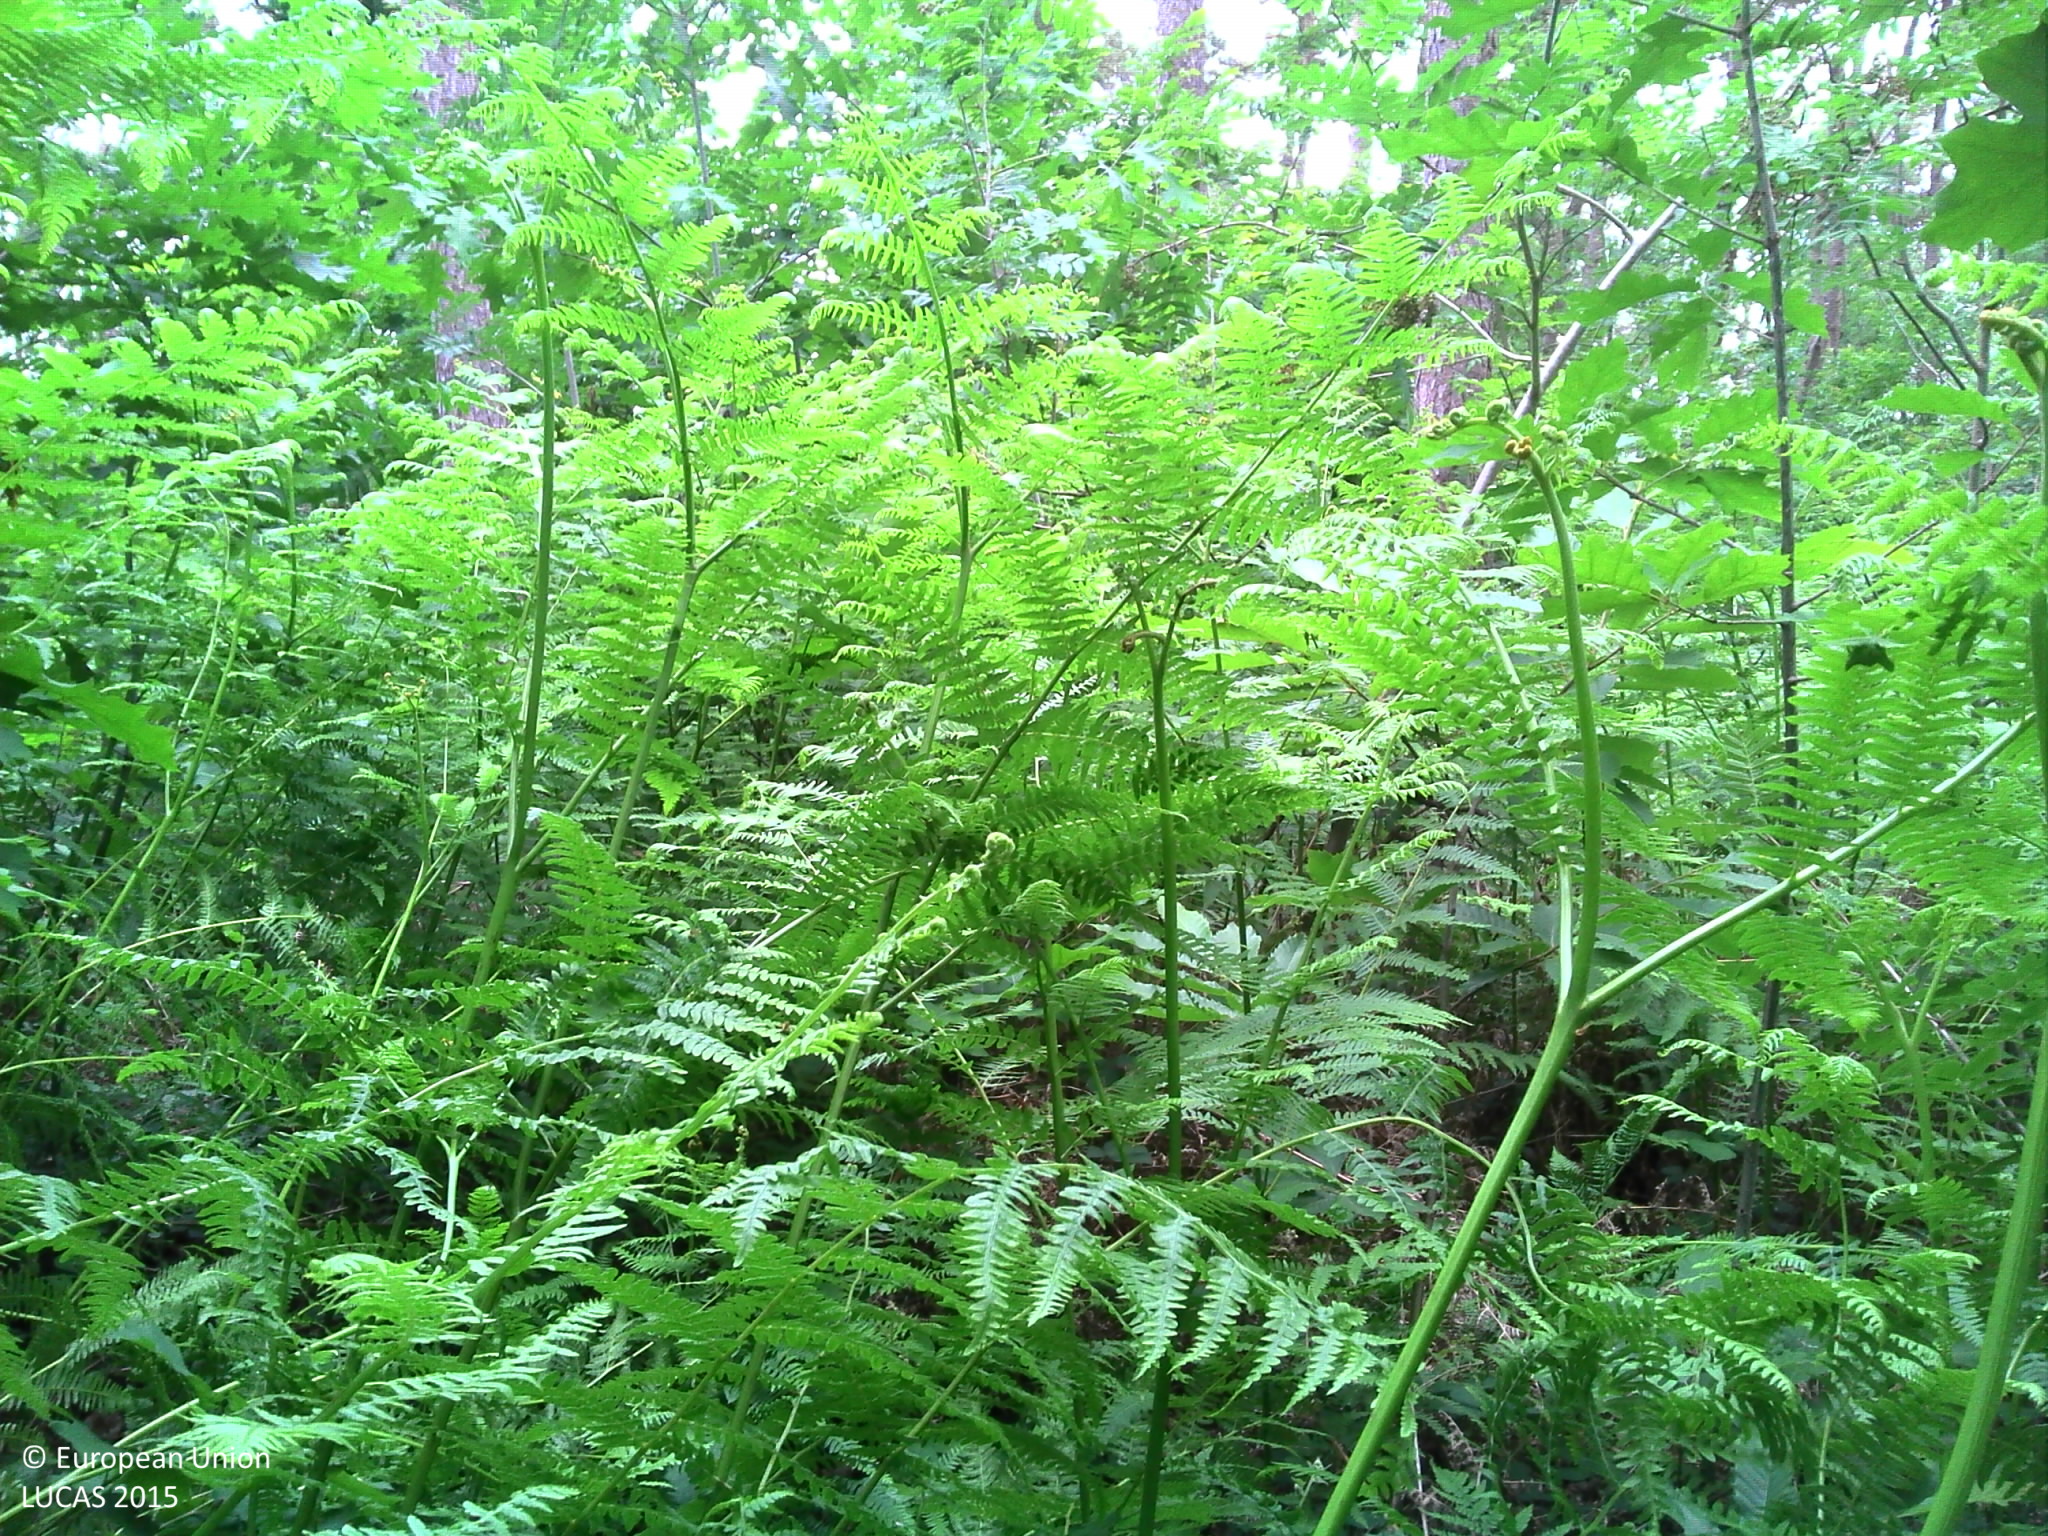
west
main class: Woodland
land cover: Pine dominated mixed woodland
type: acidophilous oak and oak-birch forest
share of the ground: > 75 %
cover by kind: broadleaved forest trees 40 %, shrubs 35 %, coniferous forest trees 20 %, herbaceous plants 5 %
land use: Forestry
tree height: > 5 m
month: June
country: BE
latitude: 50.8526
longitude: 2.9869
